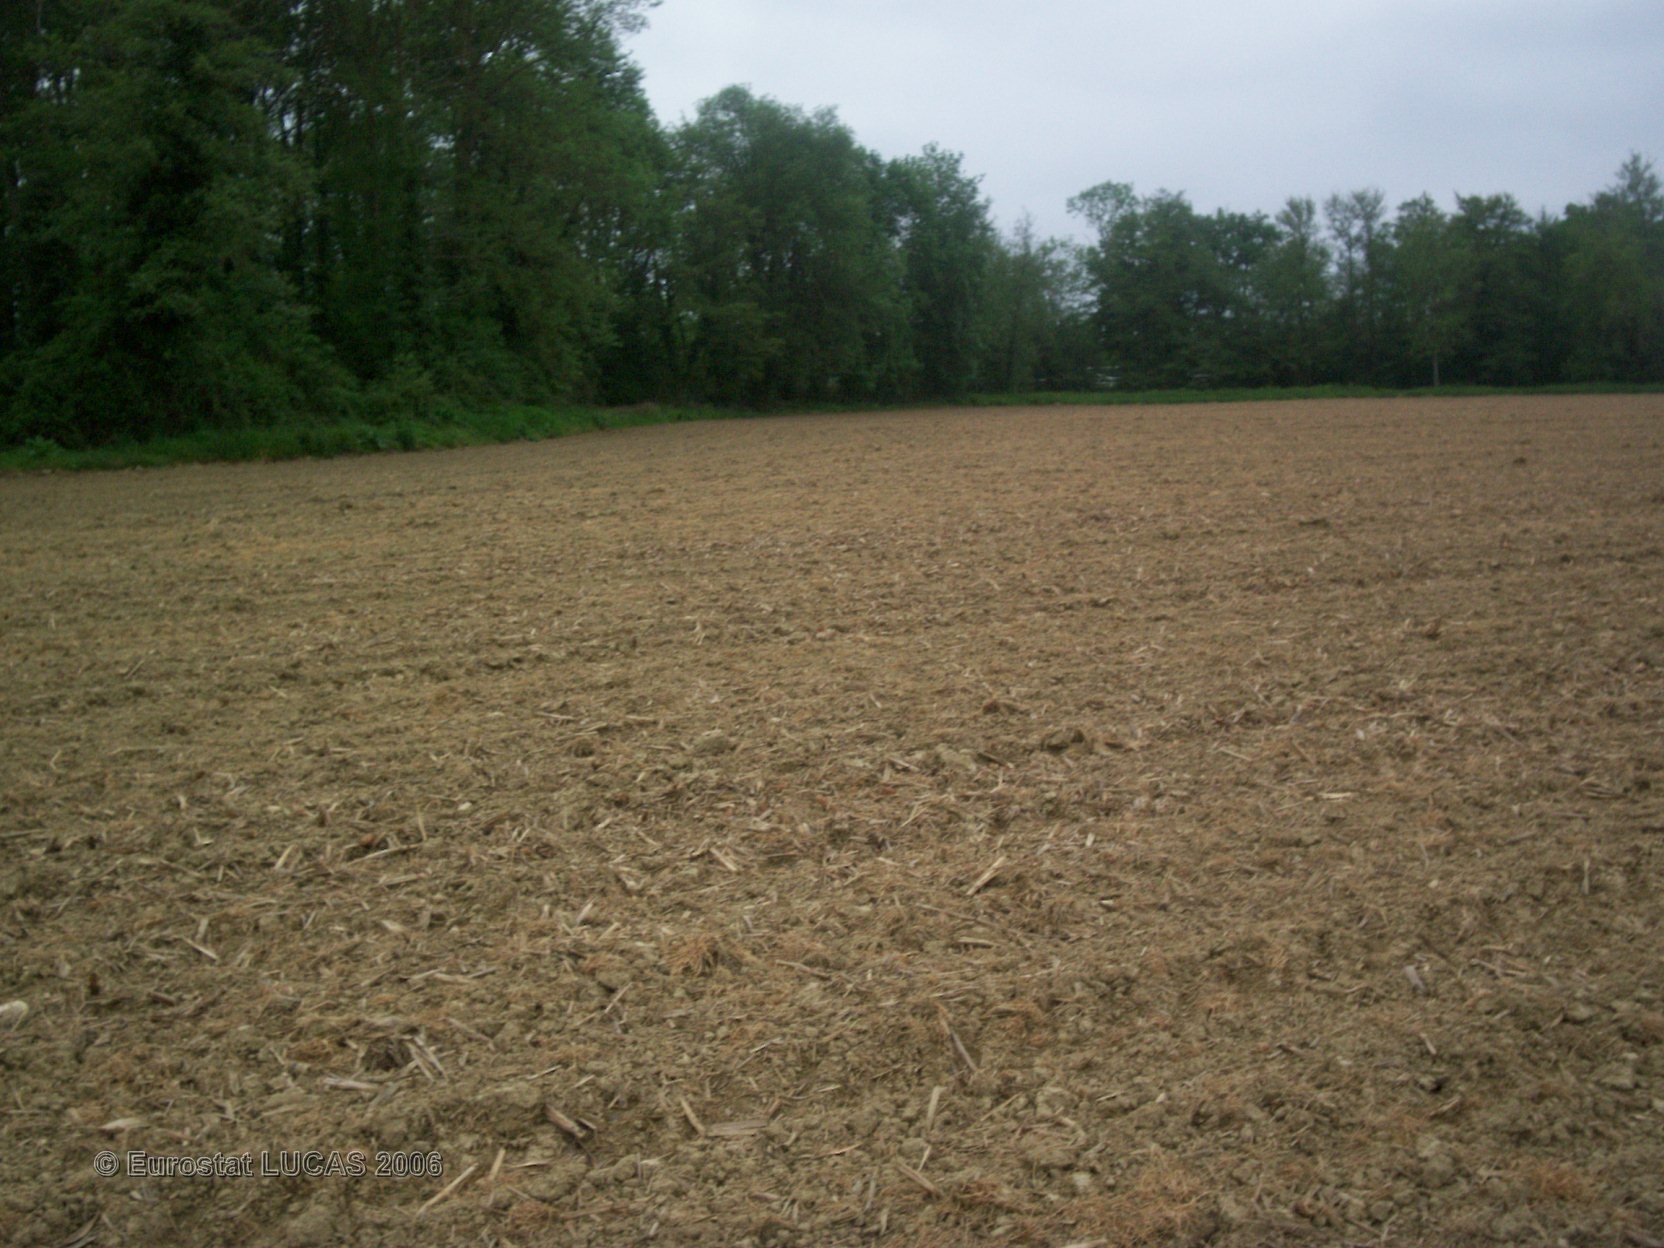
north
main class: Cropland
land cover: Maize
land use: Agriculture (excluding fallow land and kitchen gardens)
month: June
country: FR
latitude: 43.7840
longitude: -0.4610
